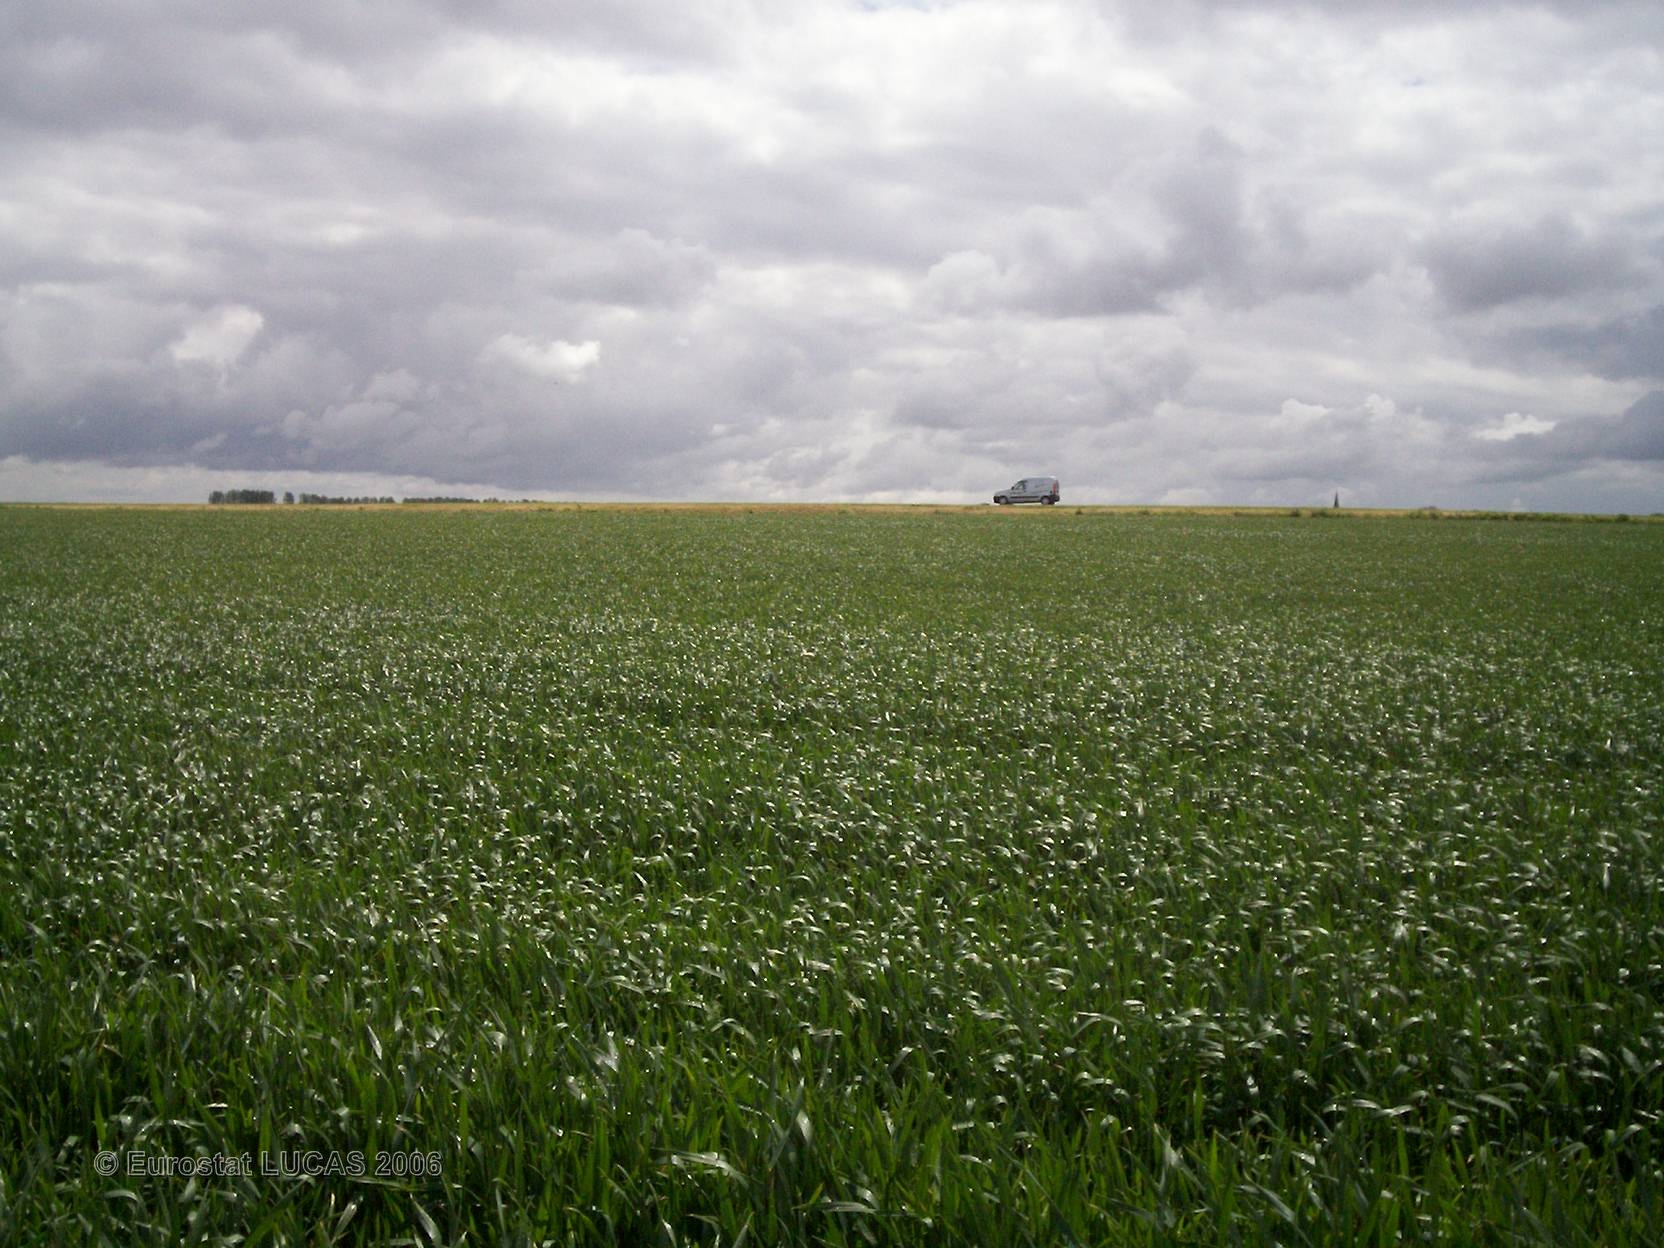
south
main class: Cropland
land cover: Common wheat
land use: Agriculture (excluding fallow land and kitchen gardens)
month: May
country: FR
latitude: 49.8732
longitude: 2.6277
